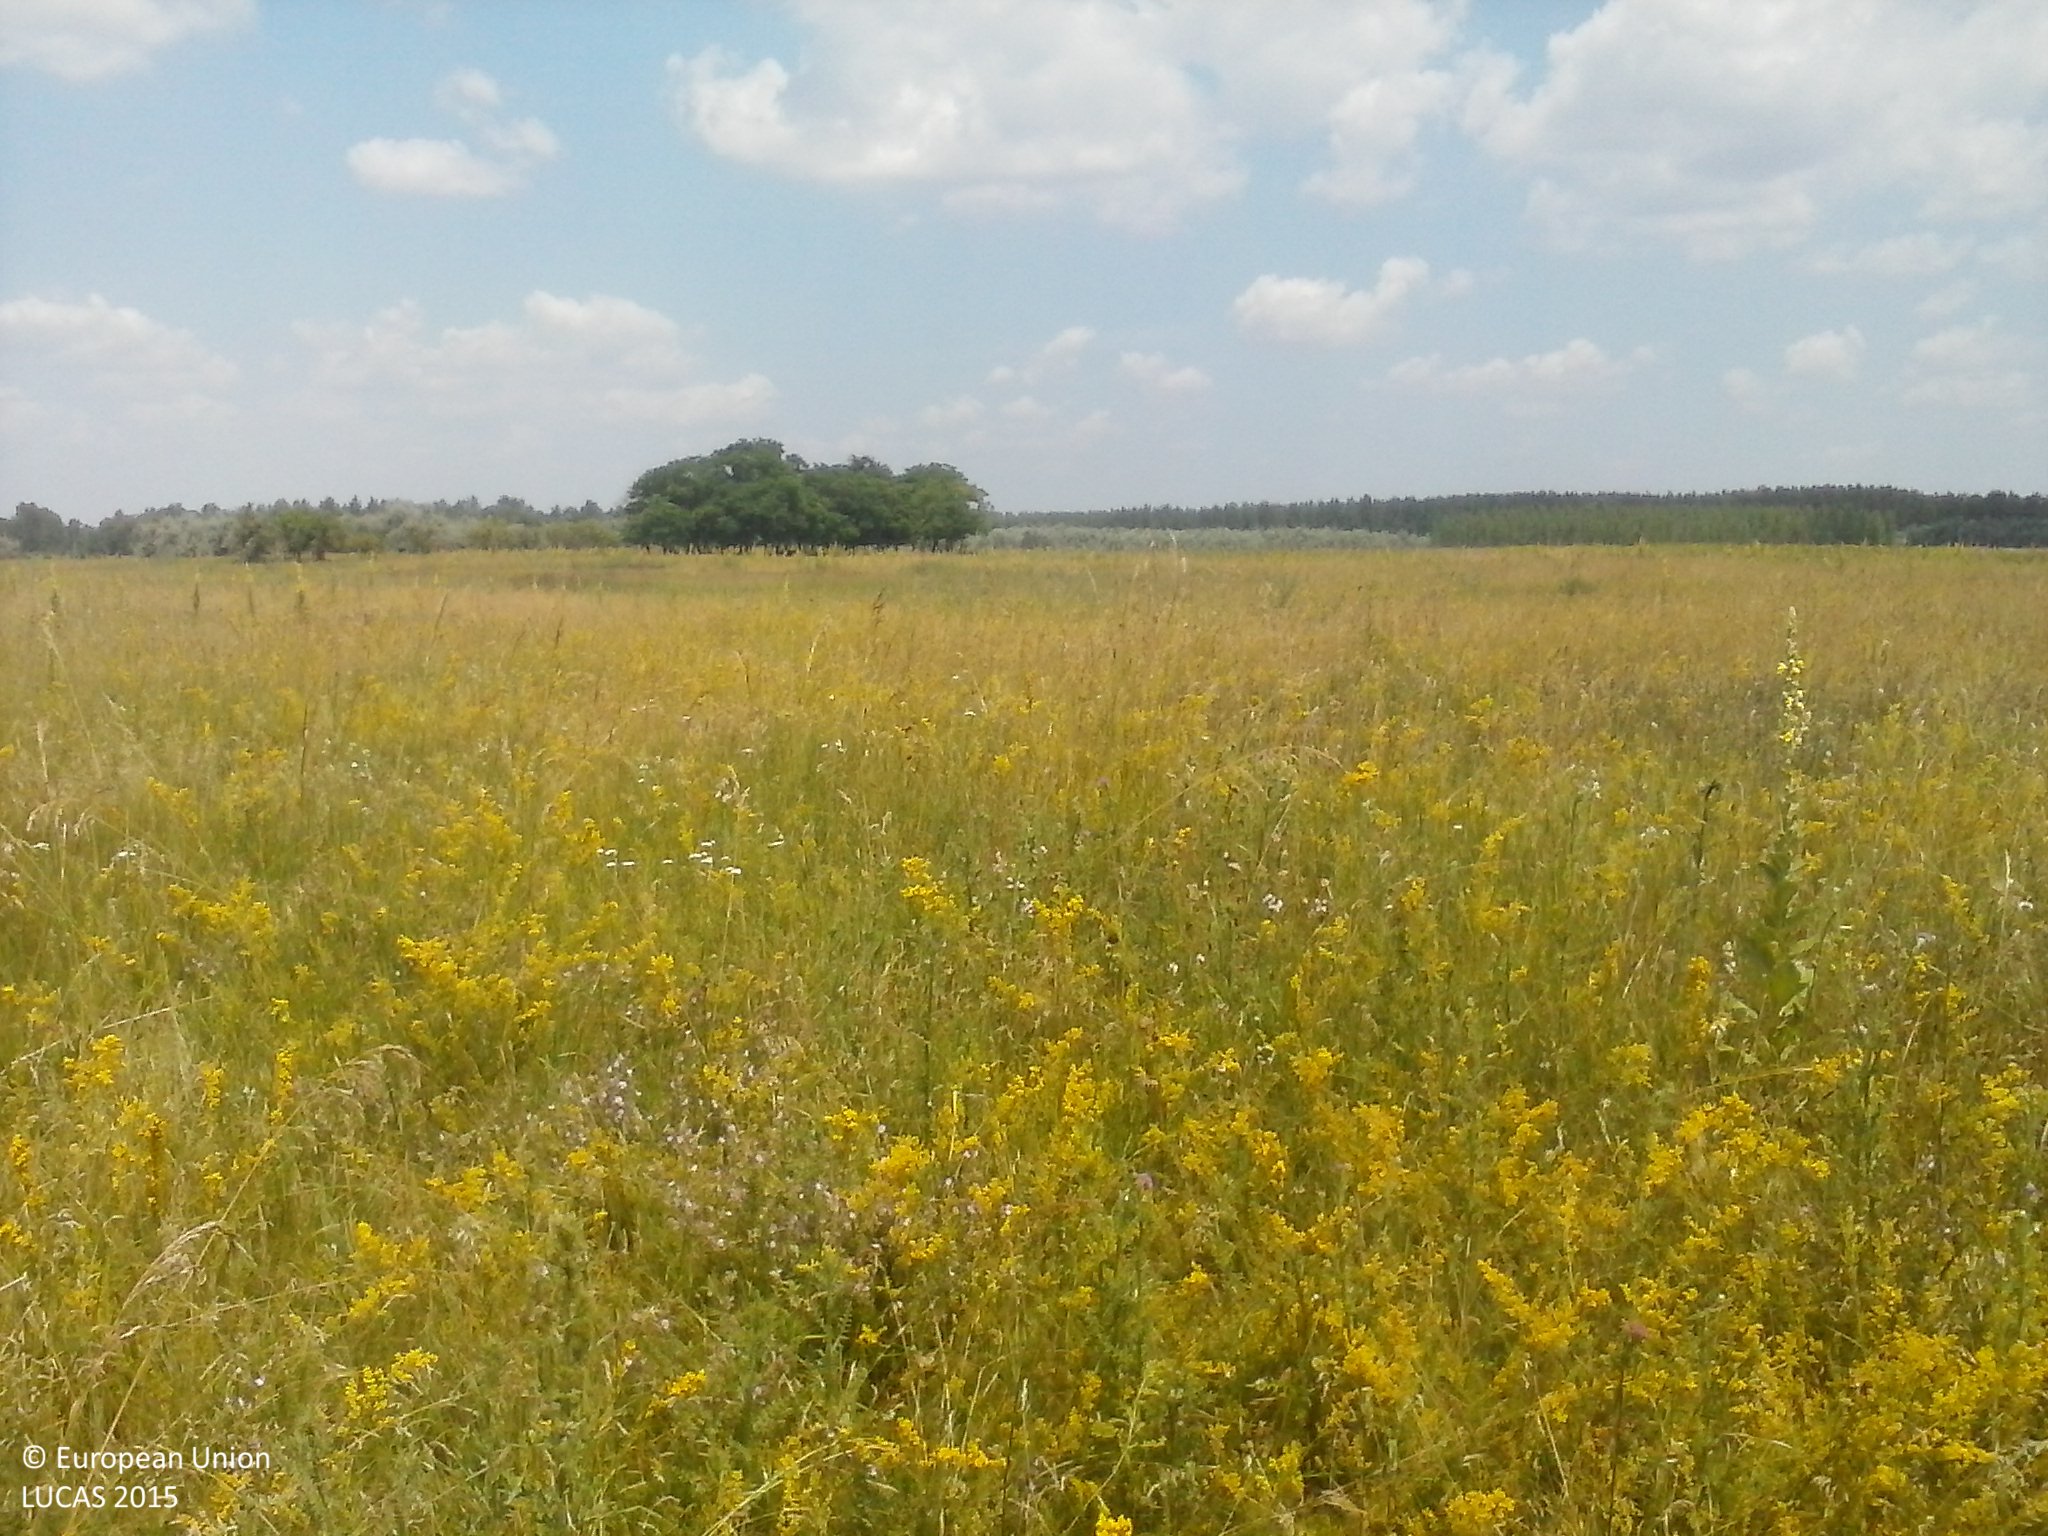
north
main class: Grassland
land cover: Grassland without tree/shrub cover
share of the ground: > 75 %
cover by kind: herbaceous plants 100 %
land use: Agriculture (excluding fallow land and kitchen gardens)
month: July
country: HU
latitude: 46.3230
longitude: 19.5373
